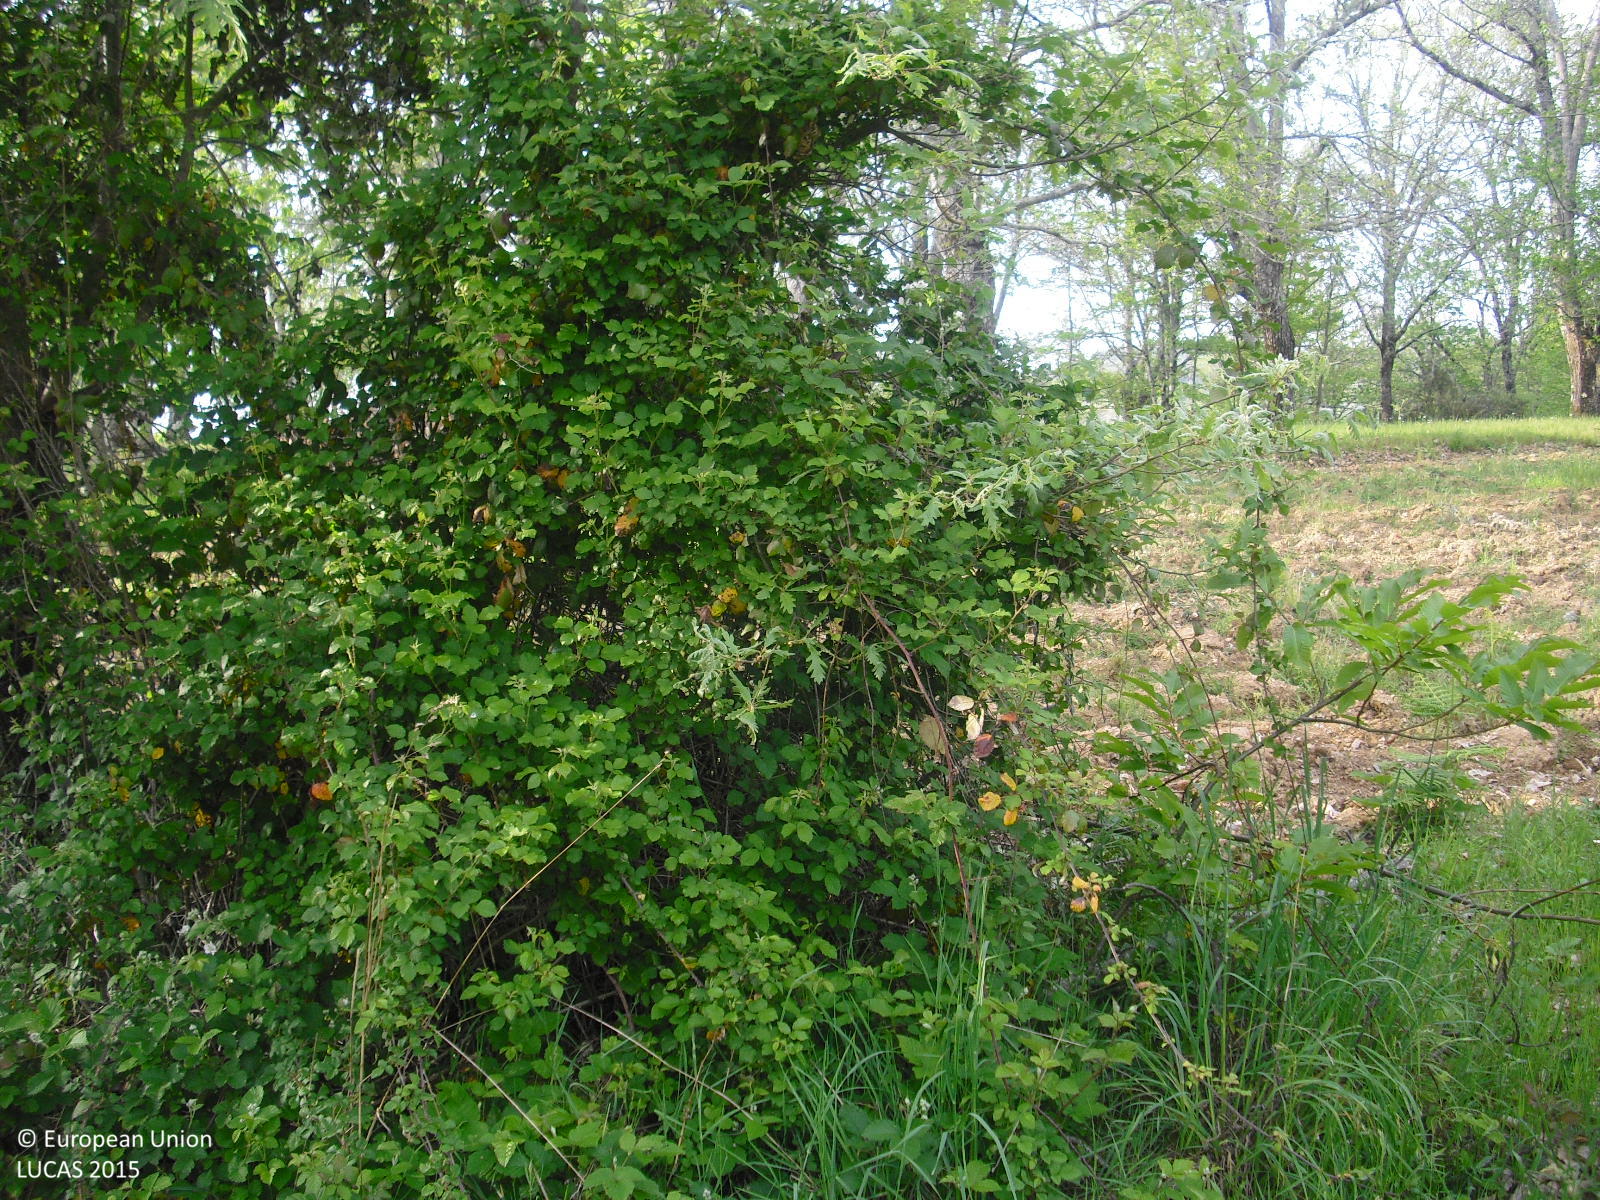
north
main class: Cropland
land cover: Nuts trees
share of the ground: 50 - 75 %
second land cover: Grassland without tree/shrub cover
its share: 50 - 75 %
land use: Agriculture (excluding fallow land and kitchen gardens)
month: May
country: ES
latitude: 41.9672
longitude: -7.2751
